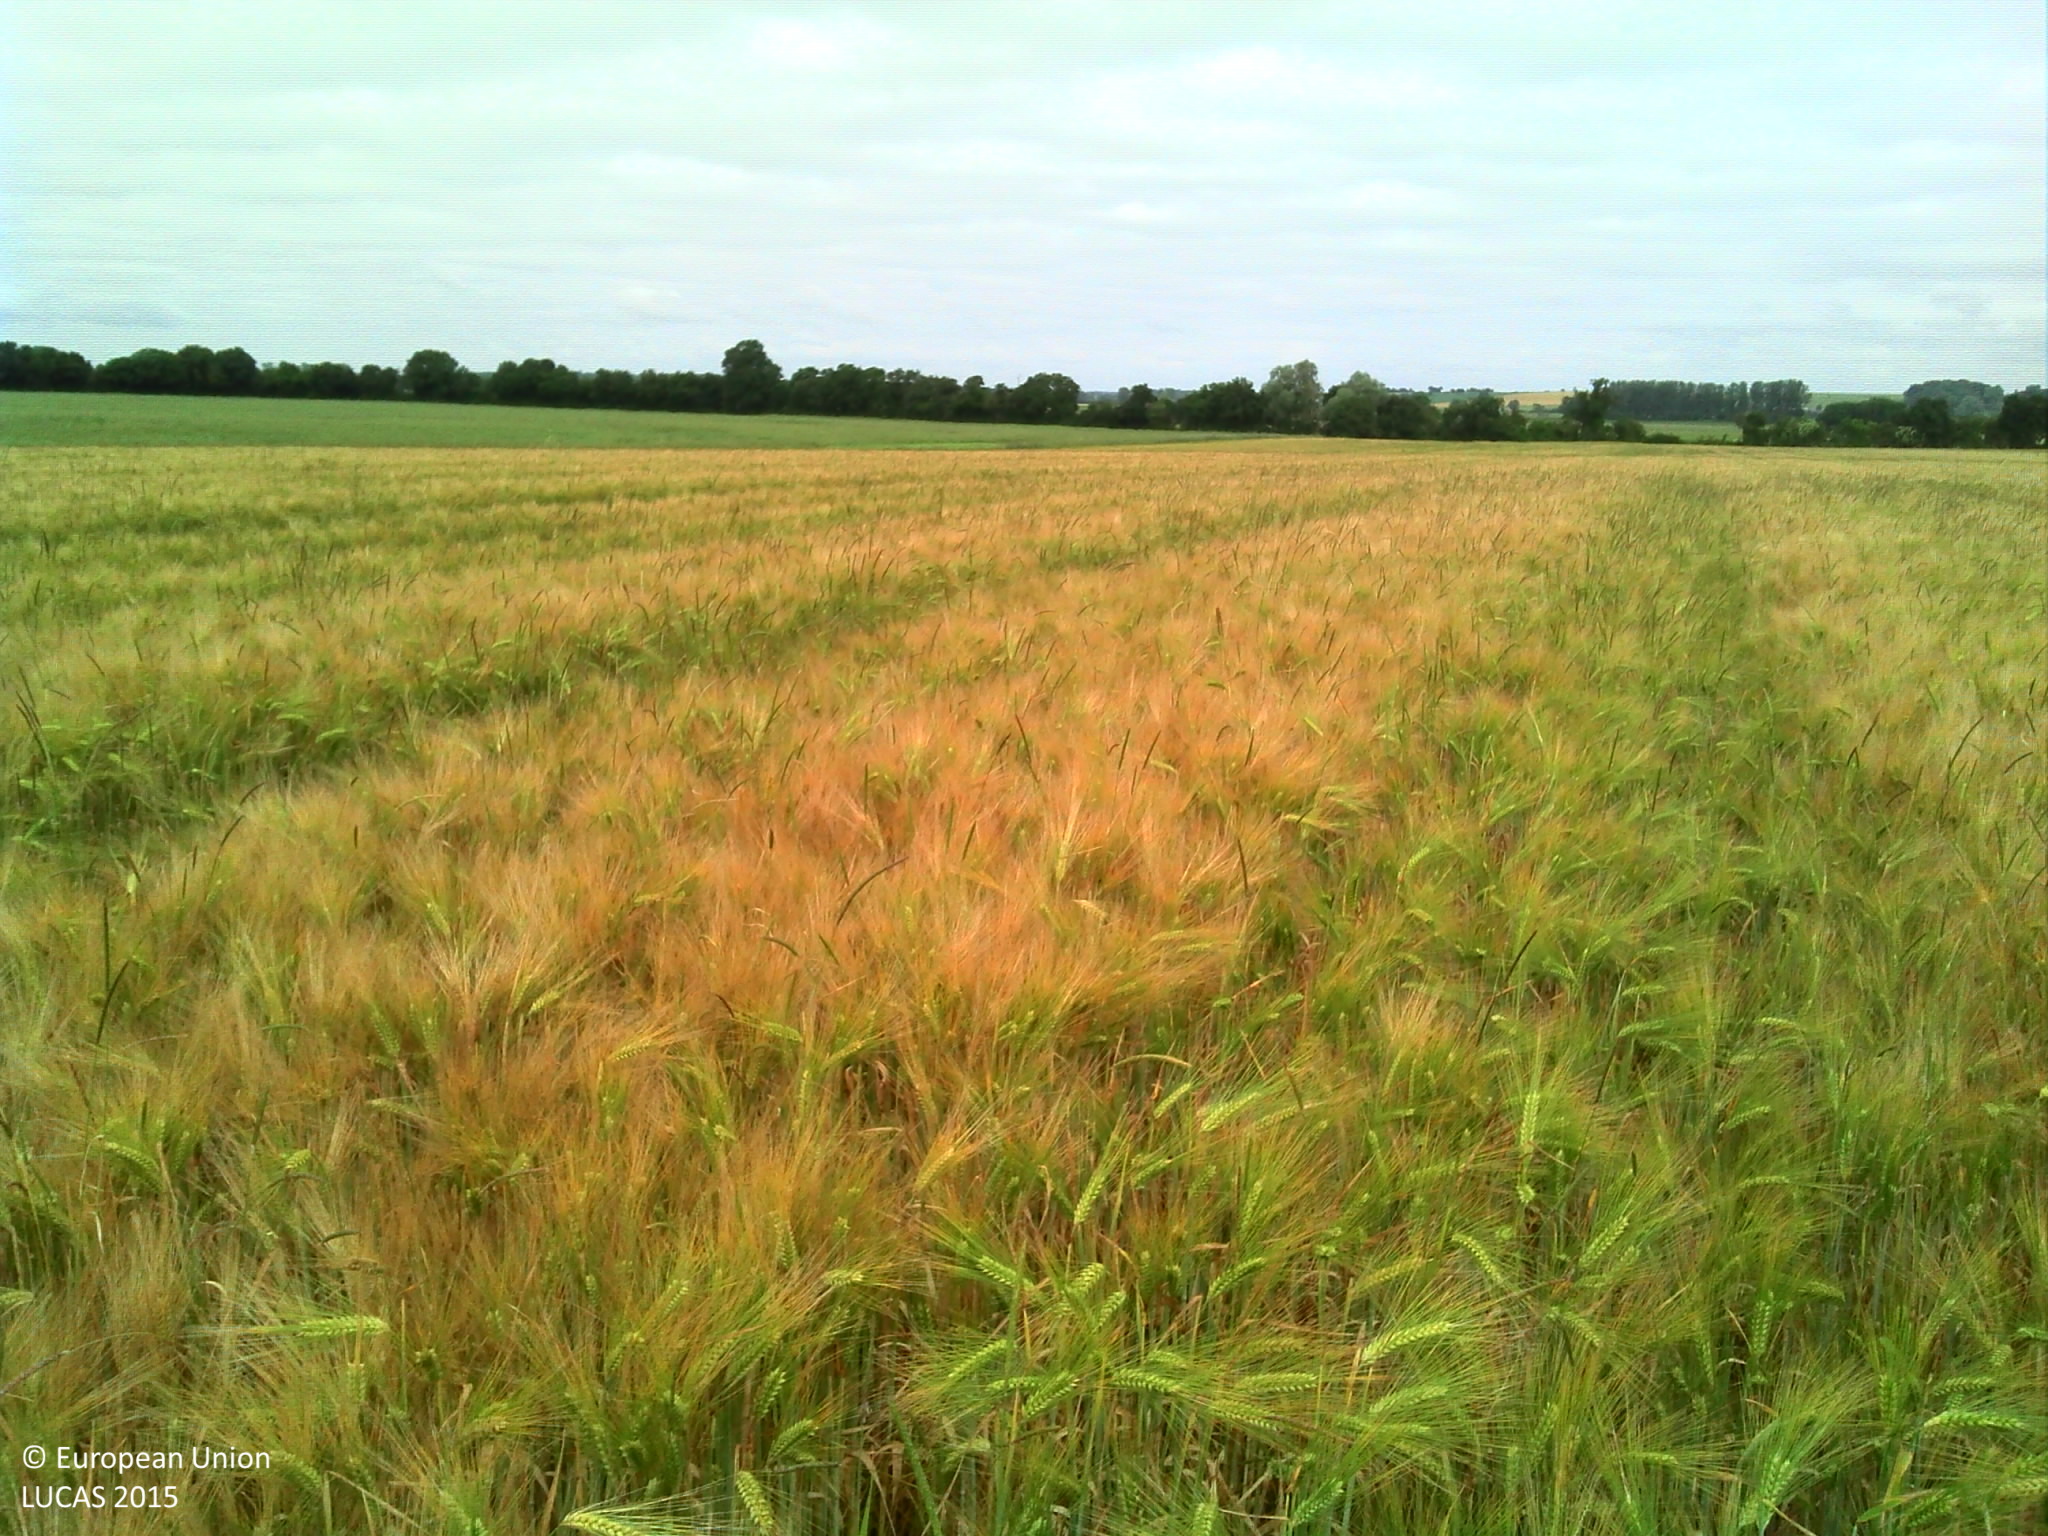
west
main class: Cropland
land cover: Barley
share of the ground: > 75 %
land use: Agriculture (excluding fallow land and kitchen gardens)
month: June
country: FR
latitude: 46.9174
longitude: 2.7334
